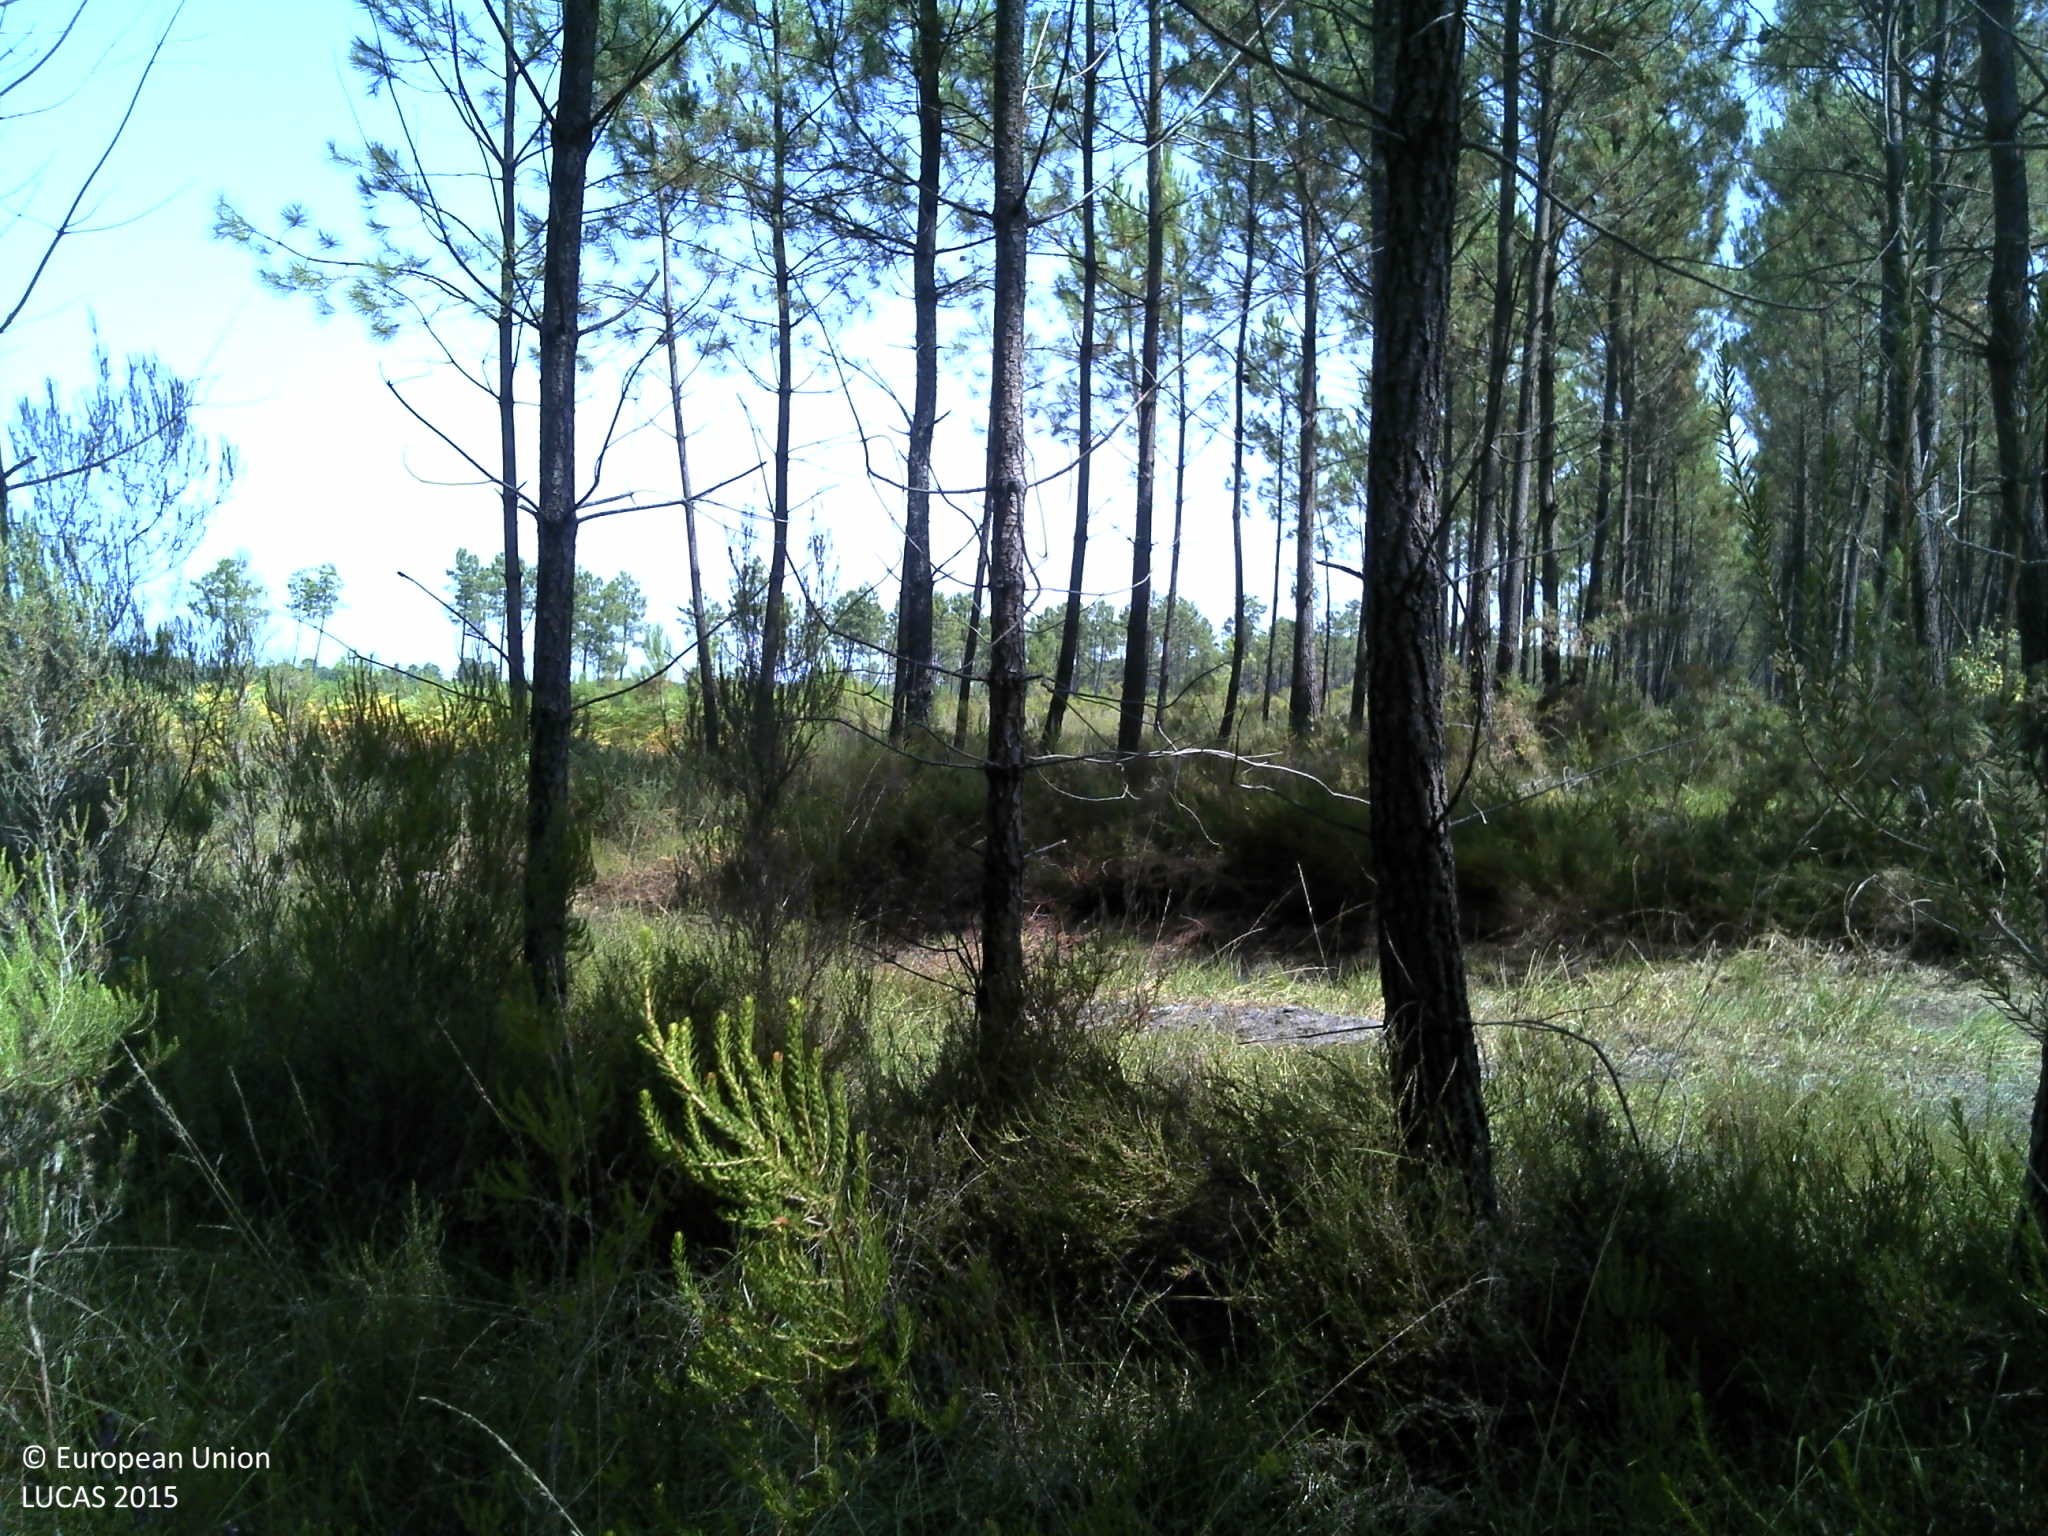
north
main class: Woodland
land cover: Pine dominated coniferous woodland
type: coniferous forest of the mediterranean region
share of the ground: > 75 %
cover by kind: coniferous forest trees 70 %, shrubs 20 %, herbaceous plants 10 %
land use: Forestry
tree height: > 5 m
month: July
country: FR
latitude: 44.5942
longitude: -0.7134
